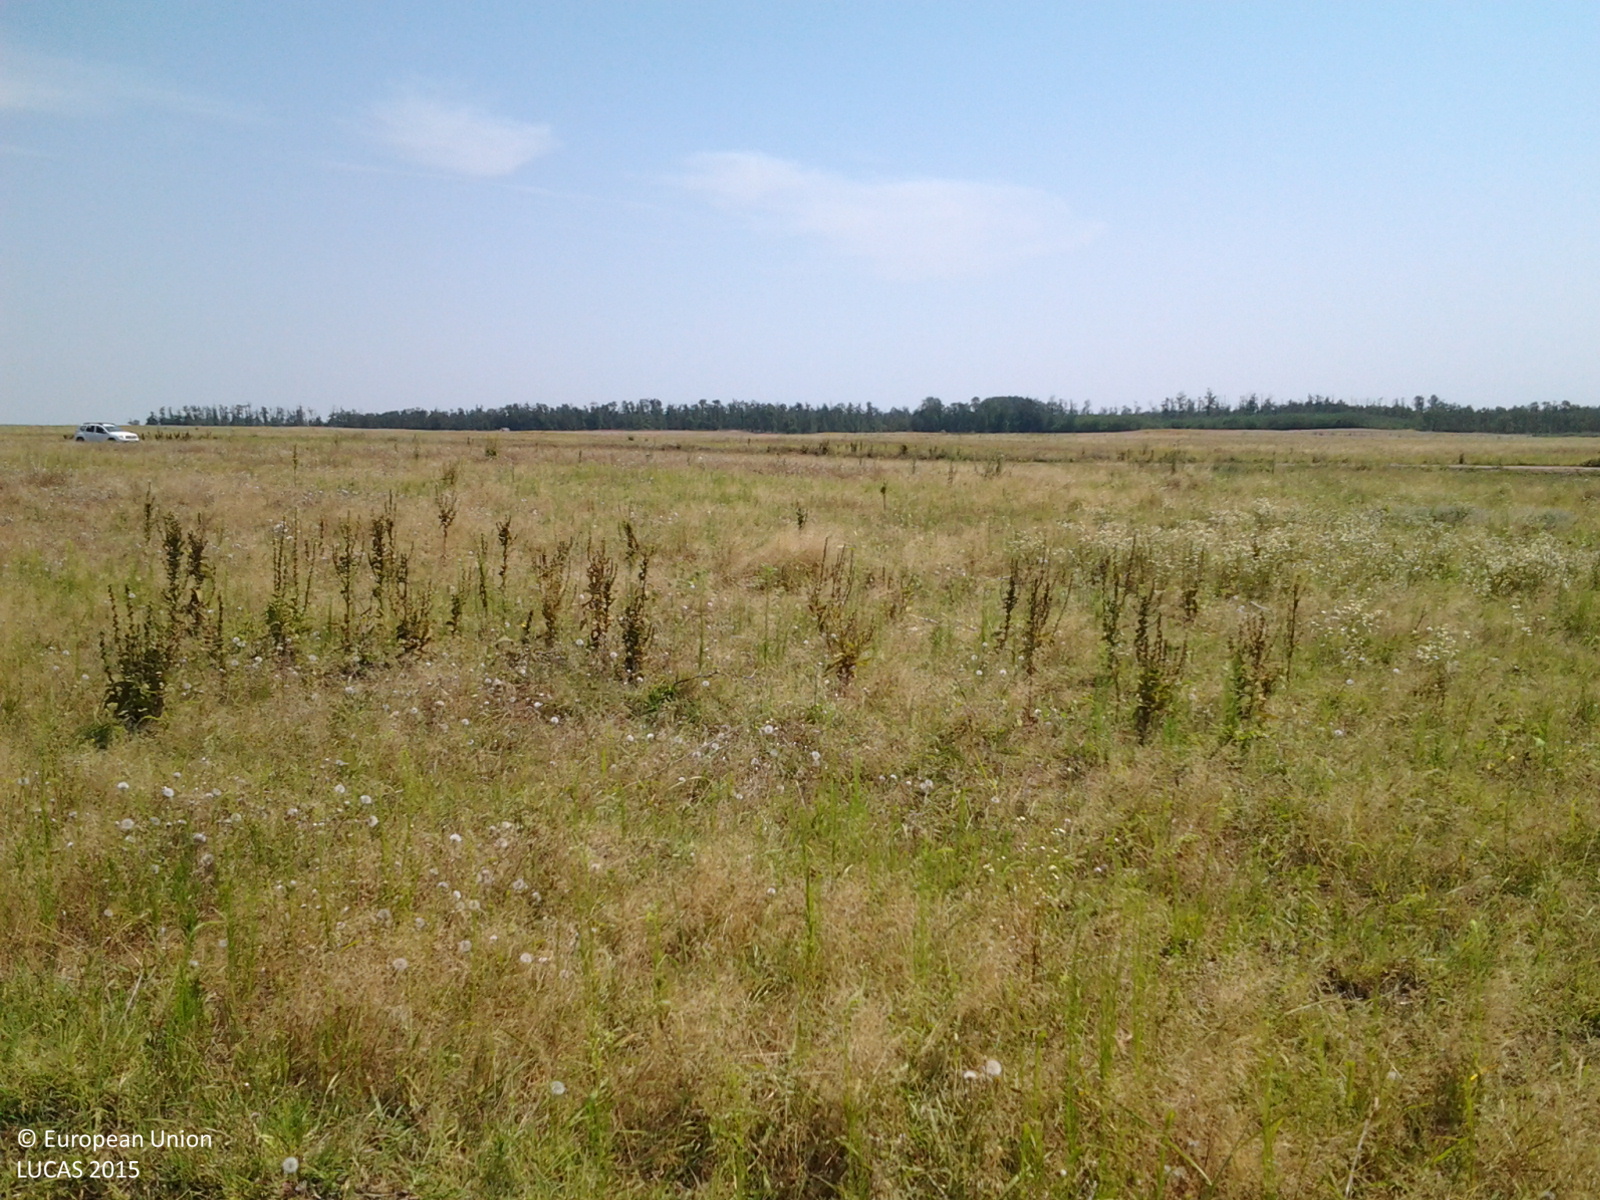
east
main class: Grassland
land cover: Grassland without tree/shrub cover
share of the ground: > 75 %
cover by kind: herbaceous plants 100 %
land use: Agriculture (excluding fallow land and kitchen gardens)
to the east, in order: Grassland without tree/shrub cover; Tracks; Grassland without tree/shrub cover
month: August
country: RO
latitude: 43.8824
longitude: 22.9465
